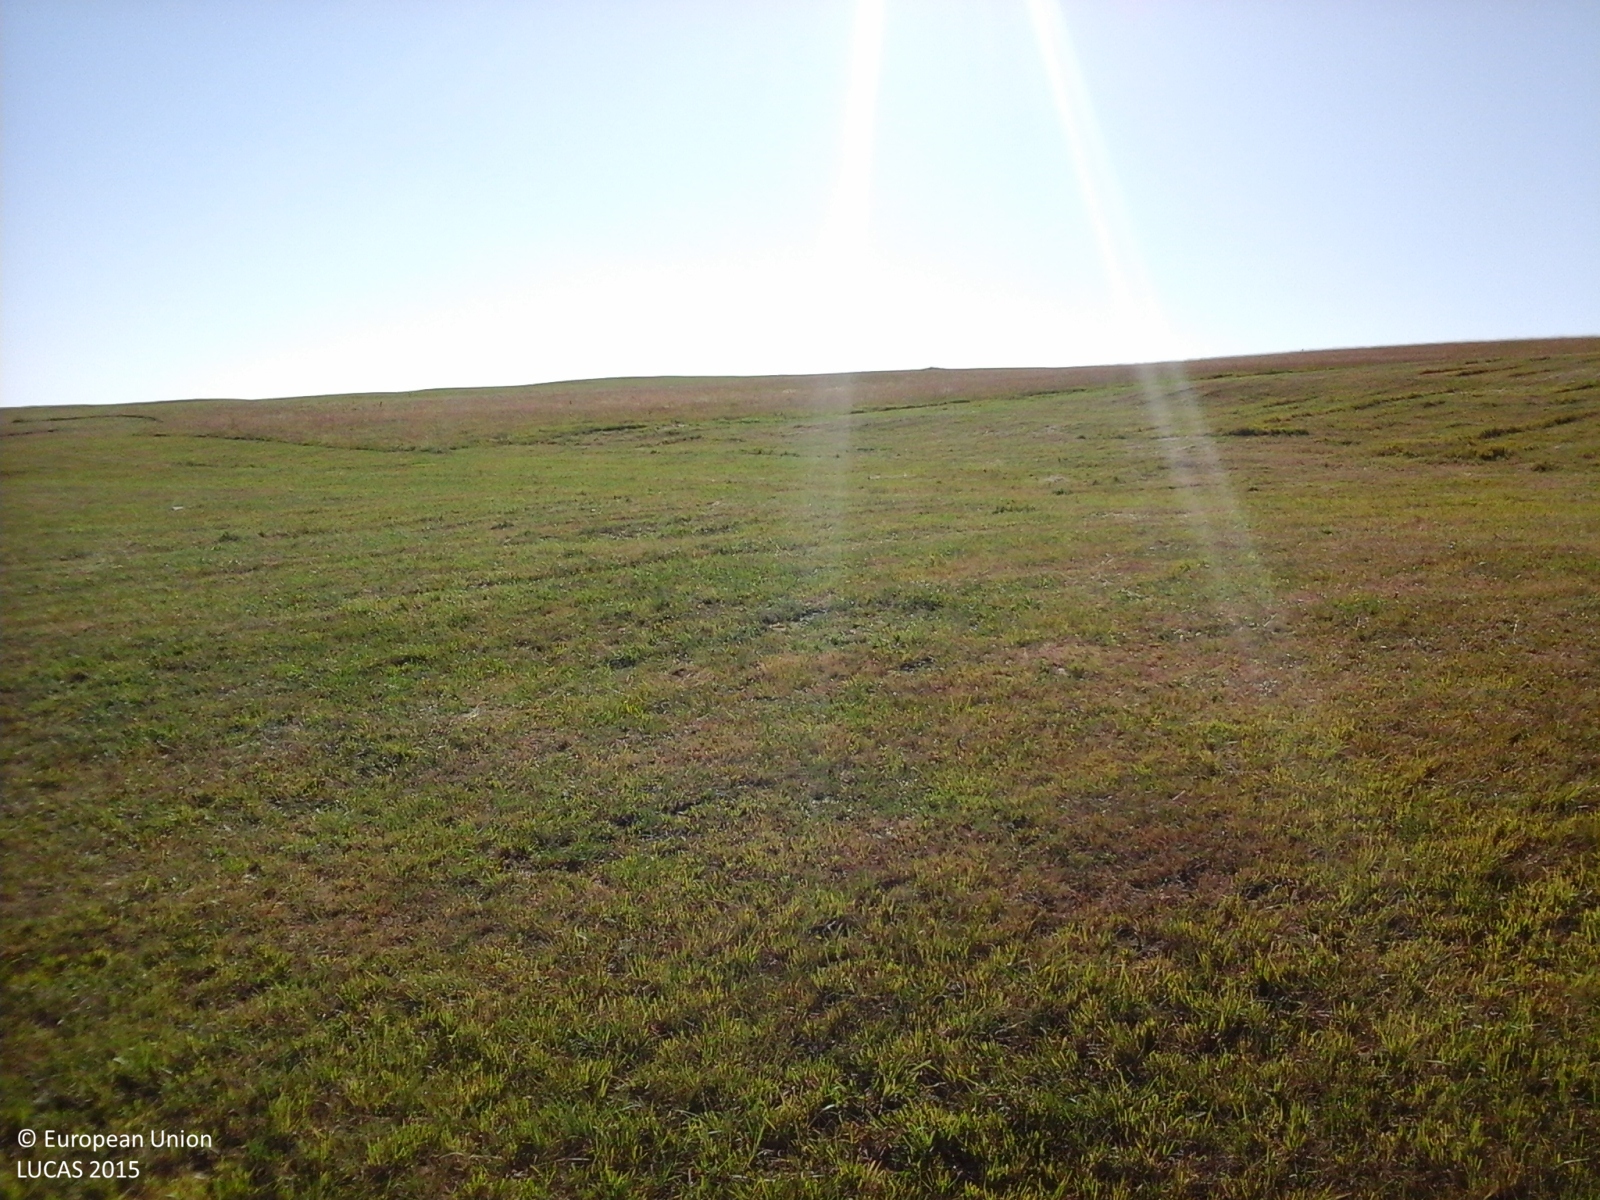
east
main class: Grassland
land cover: Grassland without tree/shrub cover
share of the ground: > 75 %
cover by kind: herbaceous plants 100 %
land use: Agriculture (excluding fallow land and kitchen gardens)
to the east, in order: Grassland without tree/shrub cover
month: August
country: IT
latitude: 43.0185
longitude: 13.2181
